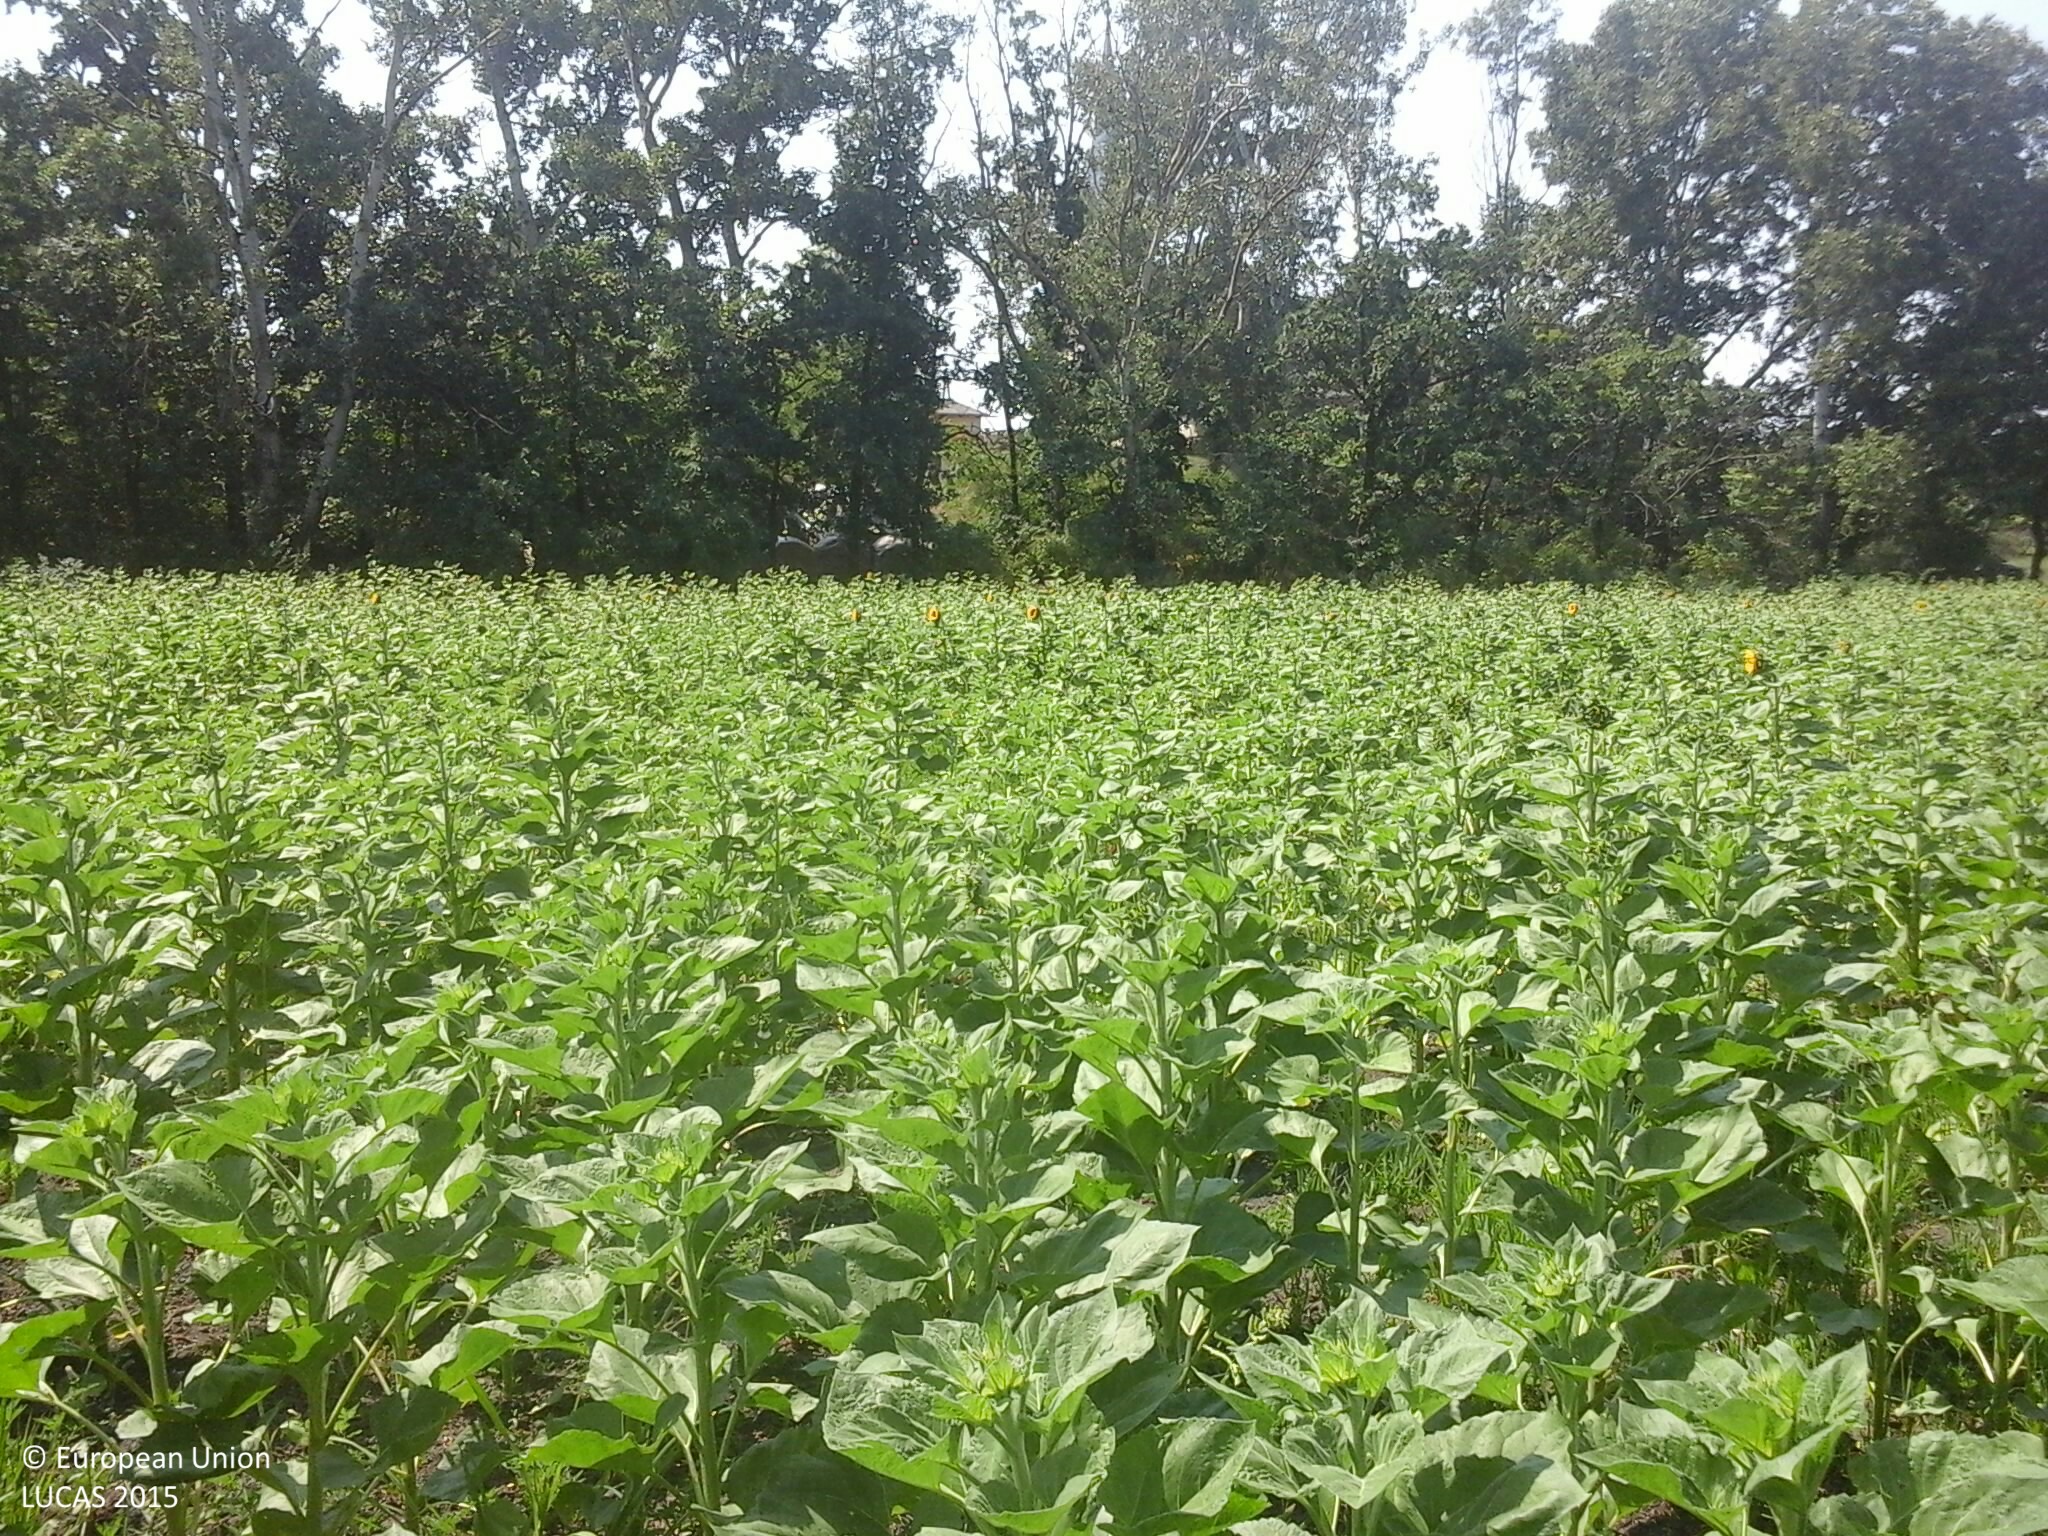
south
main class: Cropland
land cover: Sunflower
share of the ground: 50 - 75 %
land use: Agriculture (excluding fallow land and kitchen gardens)
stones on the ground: < 10 %
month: July
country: HU
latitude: 46.8053
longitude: 20.2066
